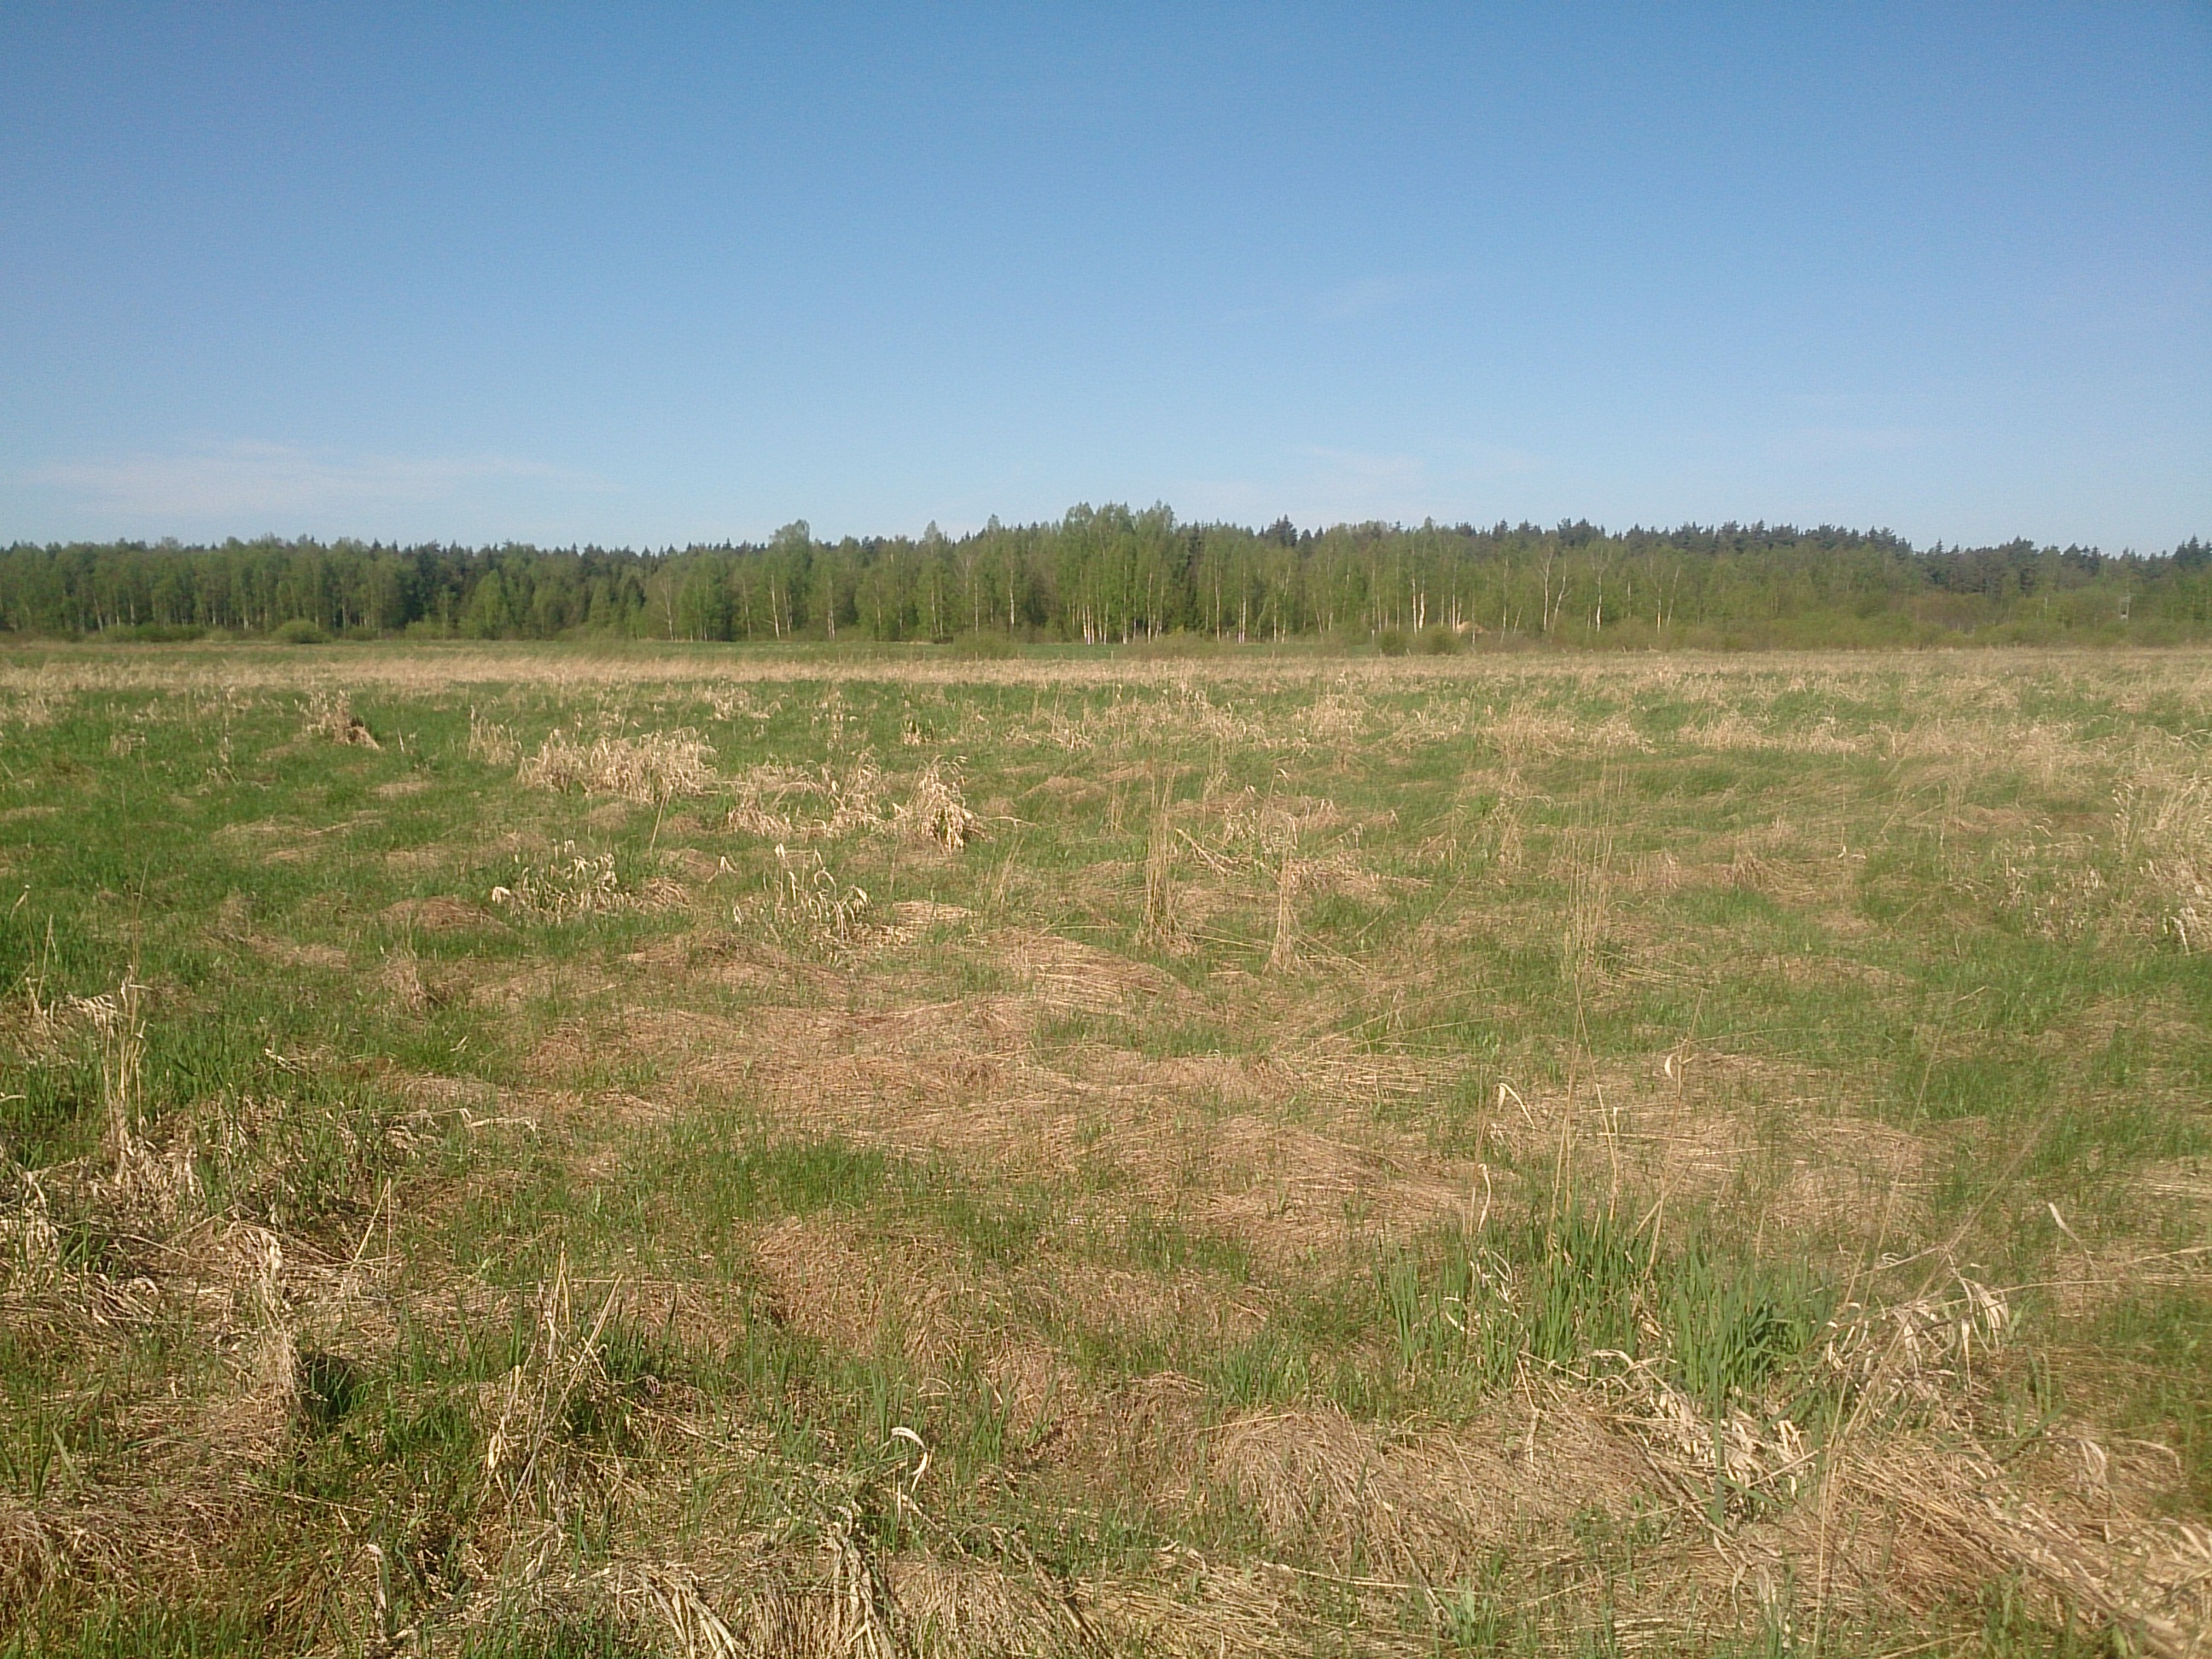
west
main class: Grassland
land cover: Spontaneously vegetated surfaces
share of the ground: > 75 %
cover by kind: herbaceous plants 100 %
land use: Agriculture (excluding fallow land and kitchen gardens)
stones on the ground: < 10 %
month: May
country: LV
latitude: 56.7743
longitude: 24.2771
